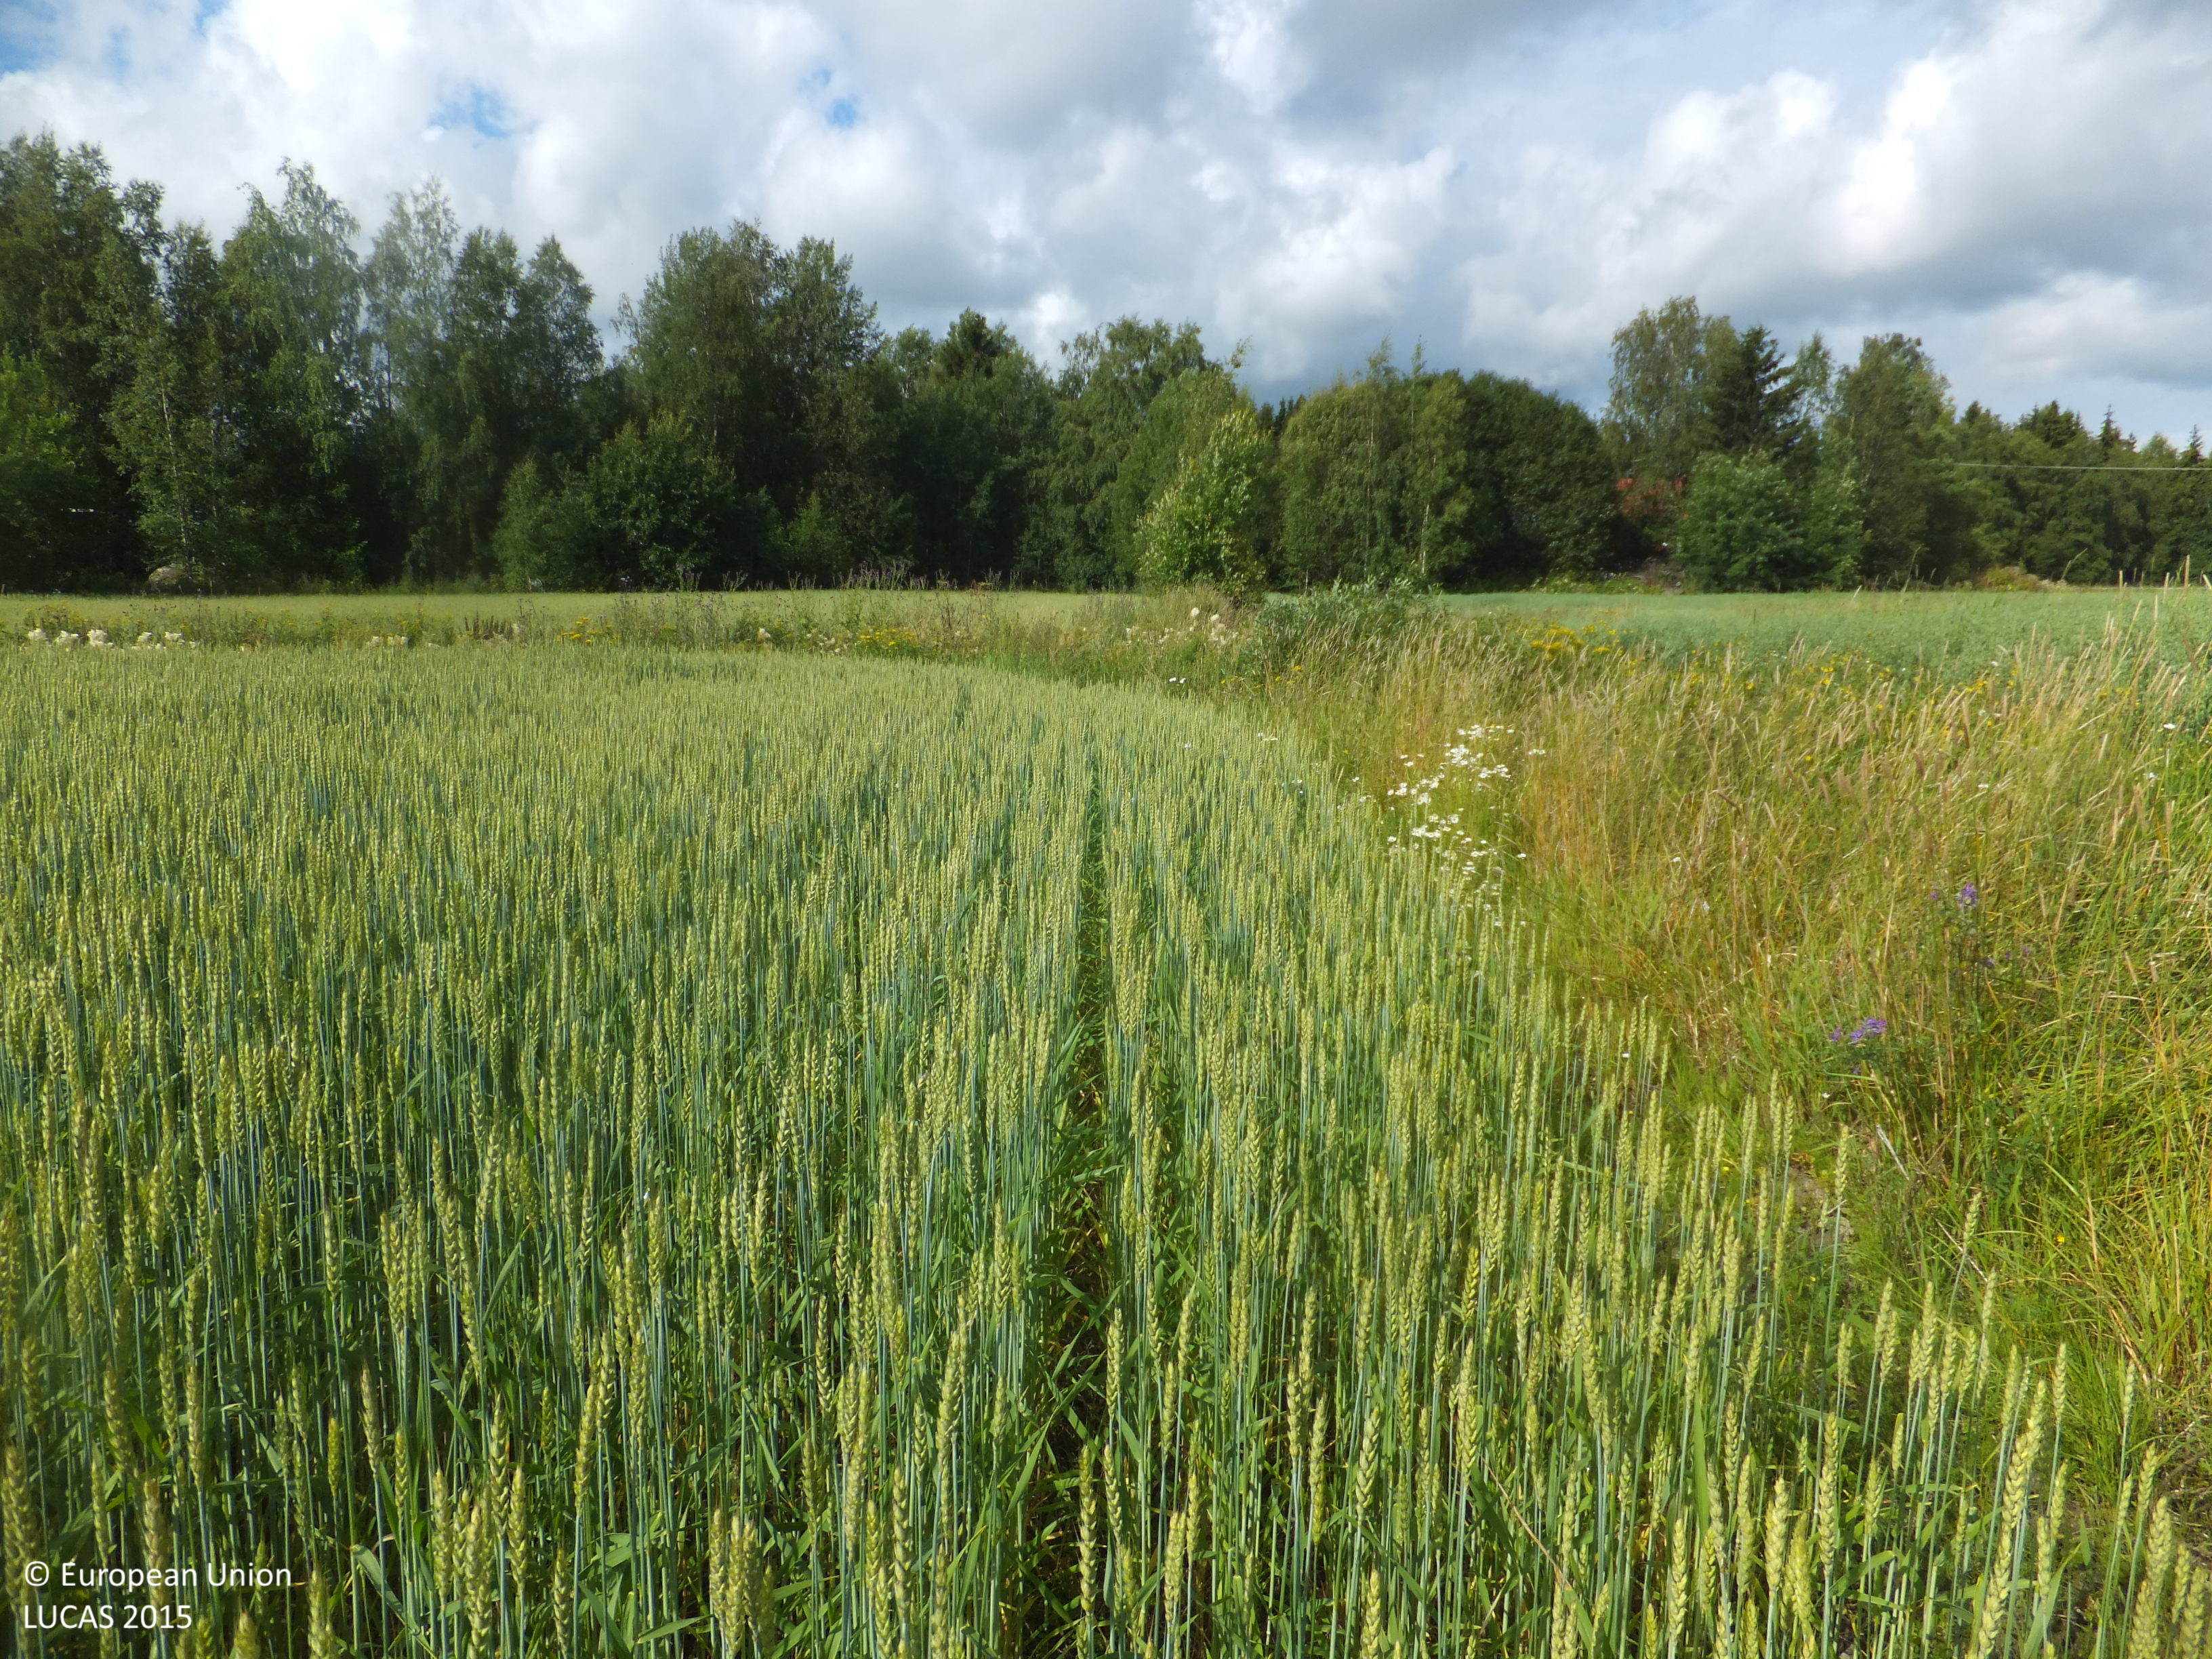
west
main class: Cropland
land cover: Common wheat
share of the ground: > 75 %
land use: Agriculture (excluding fallow land and kitchen gardens)
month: July
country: FI
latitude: 63.0702
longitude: 22.1387
